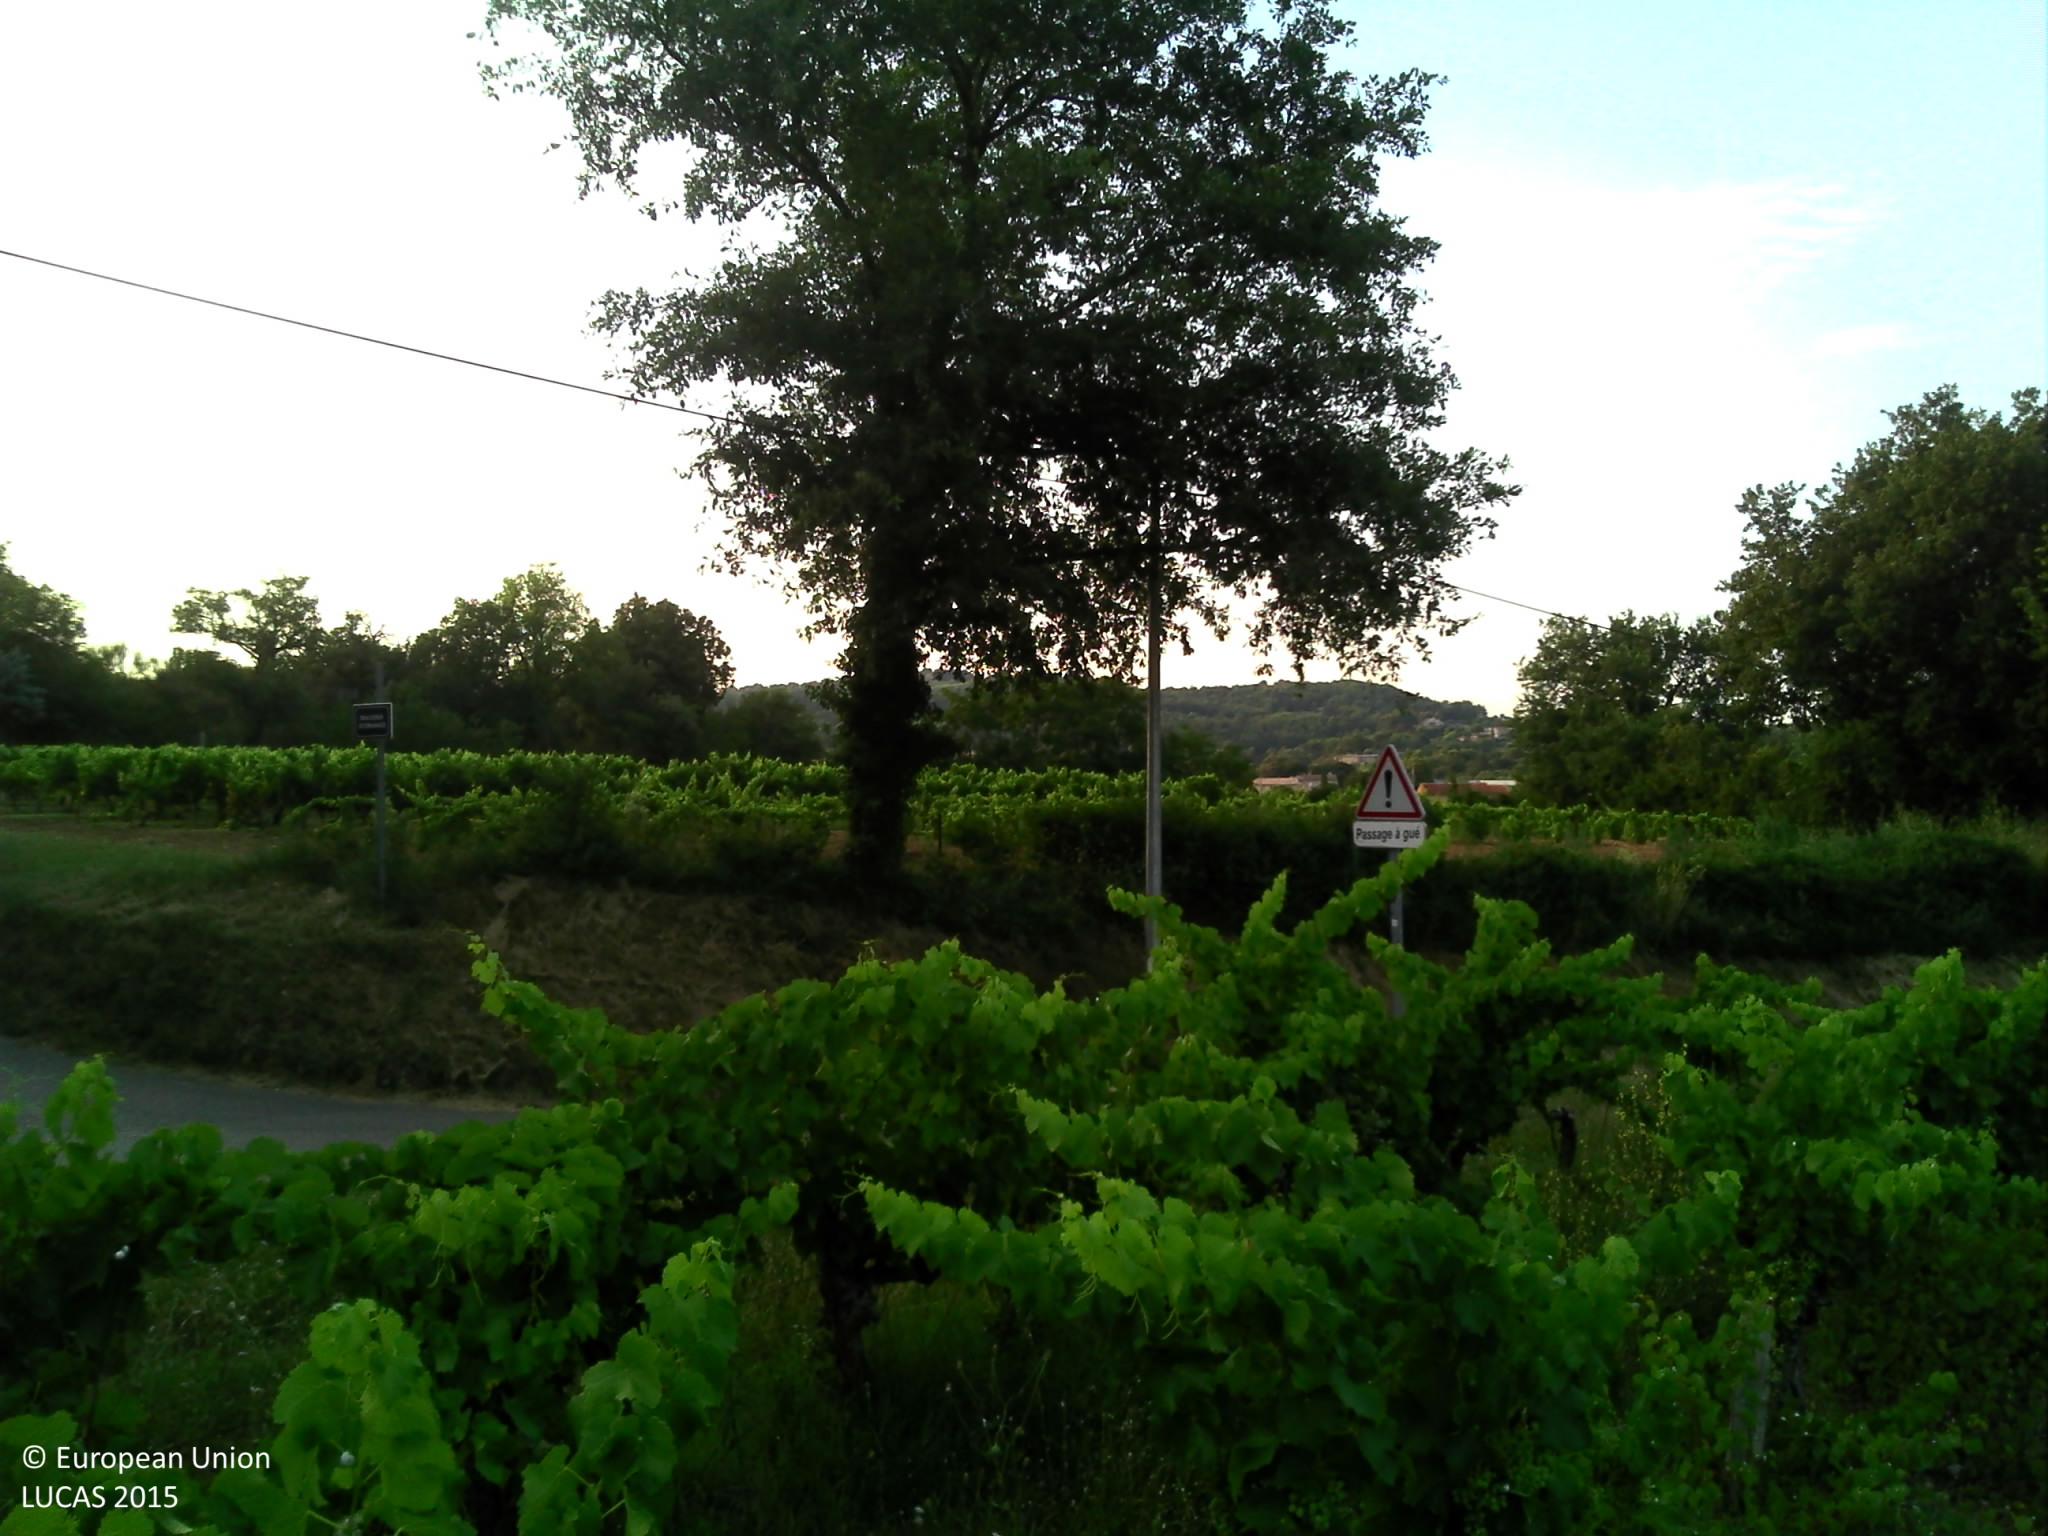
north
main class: Cropland
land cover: Vineyards
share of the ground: > 75 %
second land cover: Spontaneously vegetated surfaces
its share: > 75 %
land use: Agriculture (excluding fallow land and kitchen gardens)
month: July
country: FR
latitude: 44.2522
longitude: 5.0857
